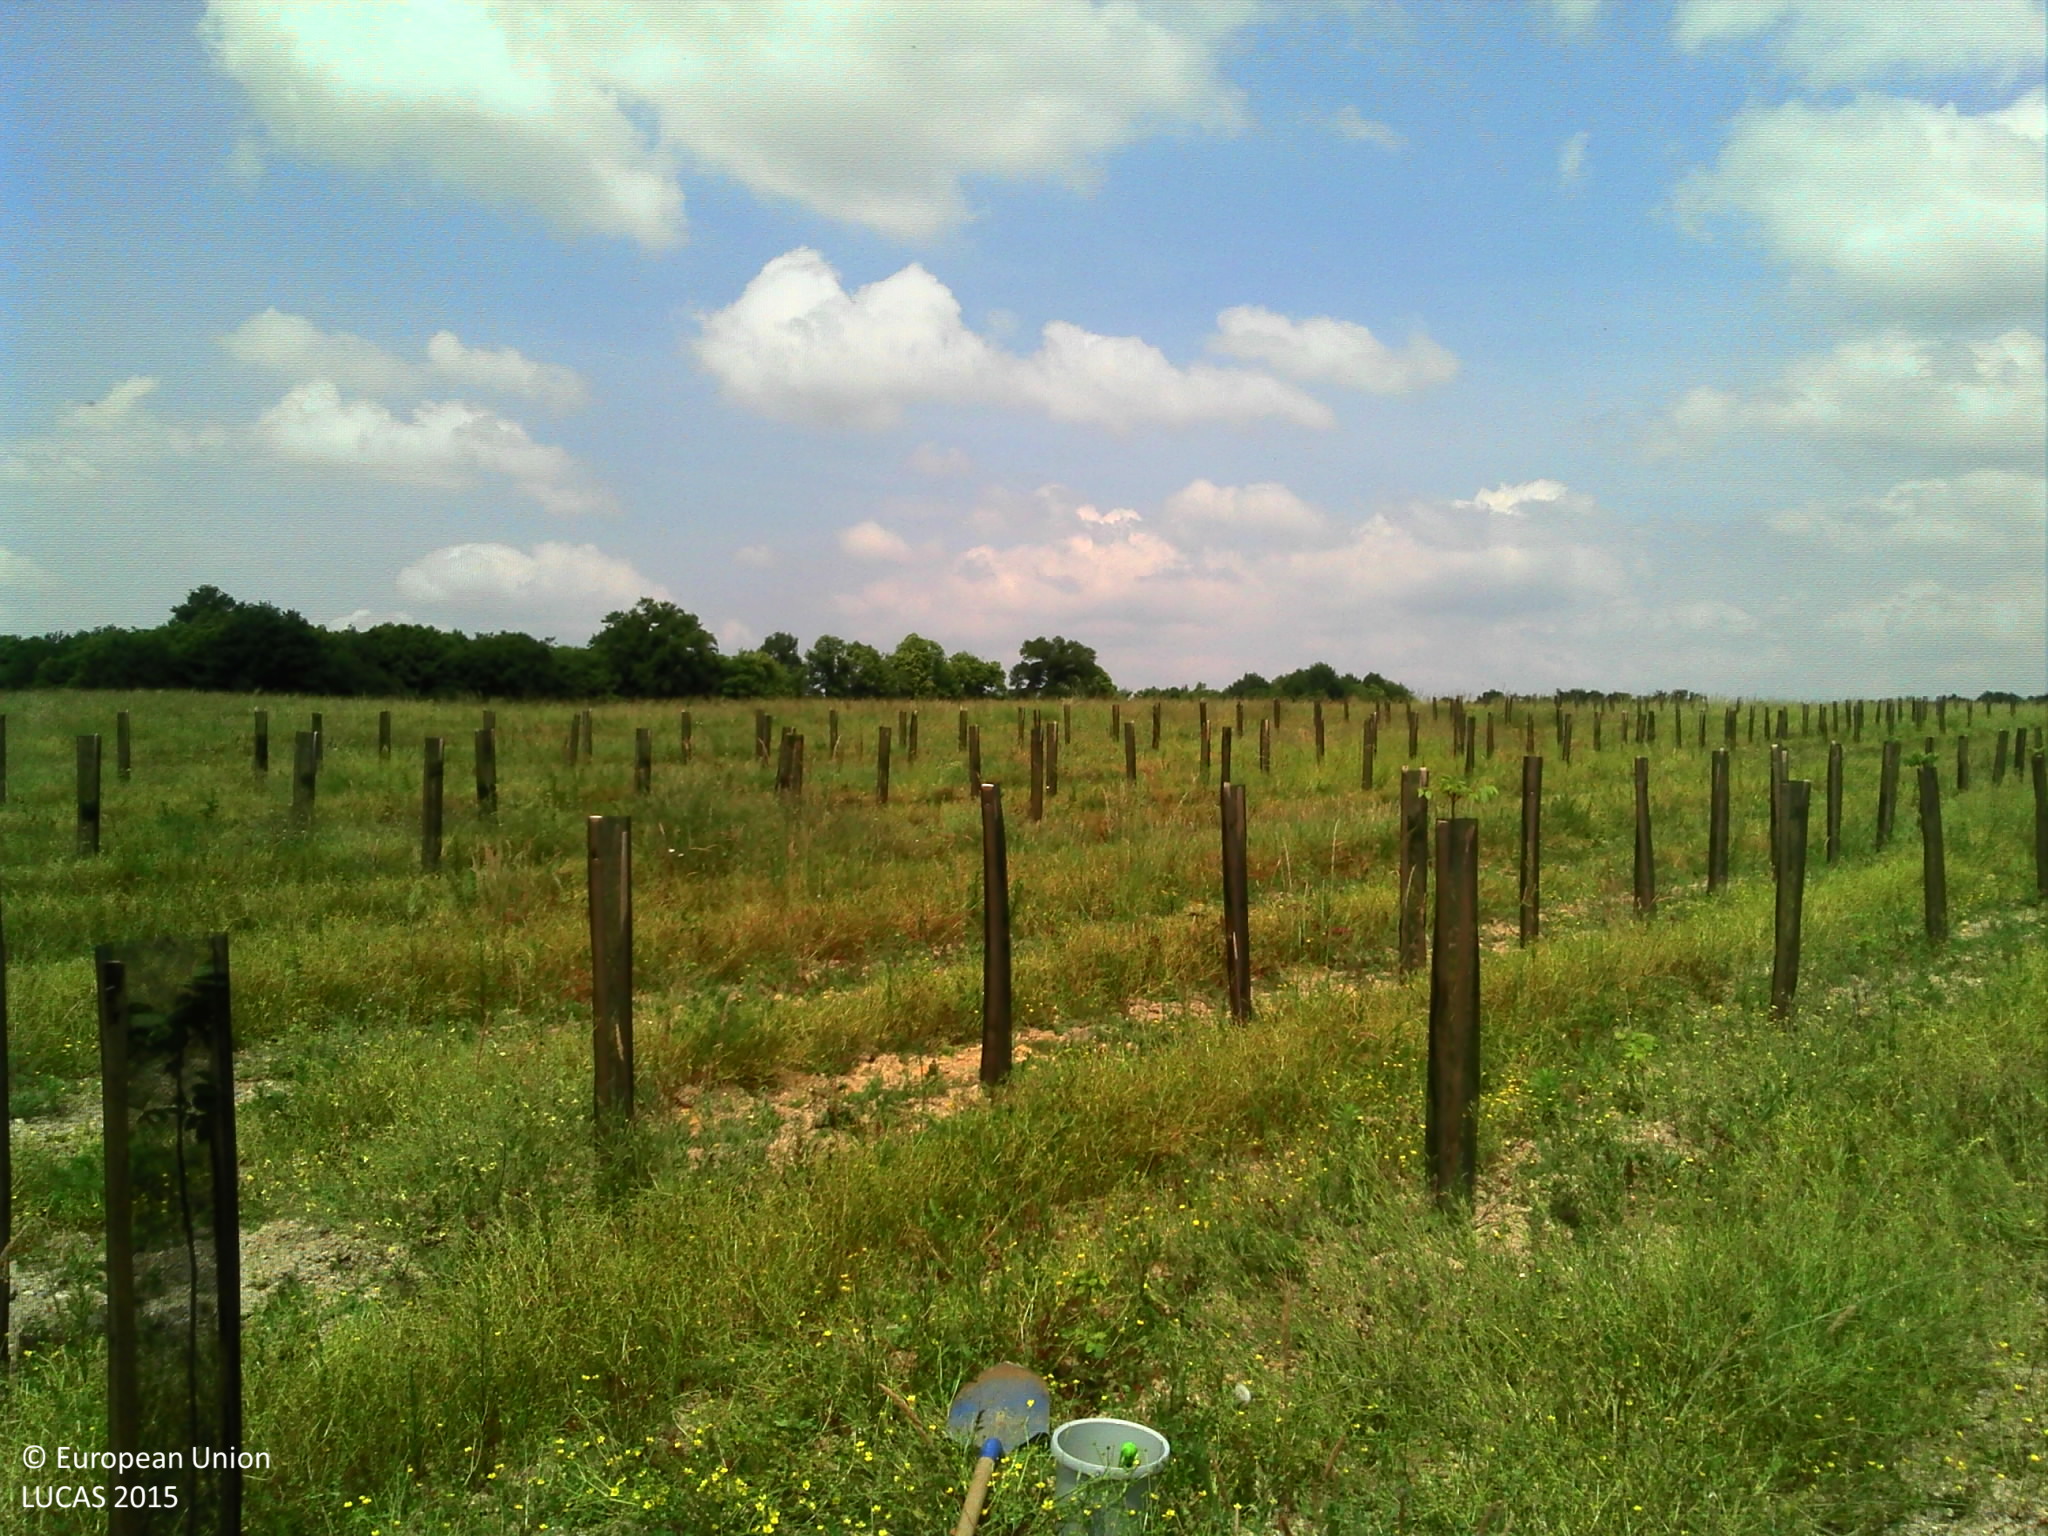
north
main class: Cropland
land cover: Nurseries
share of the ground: 10 - 25 %
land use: Forestry
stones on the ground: 10 - 25 %
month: June
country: FR
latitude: 45.9885
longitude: 0.5741
